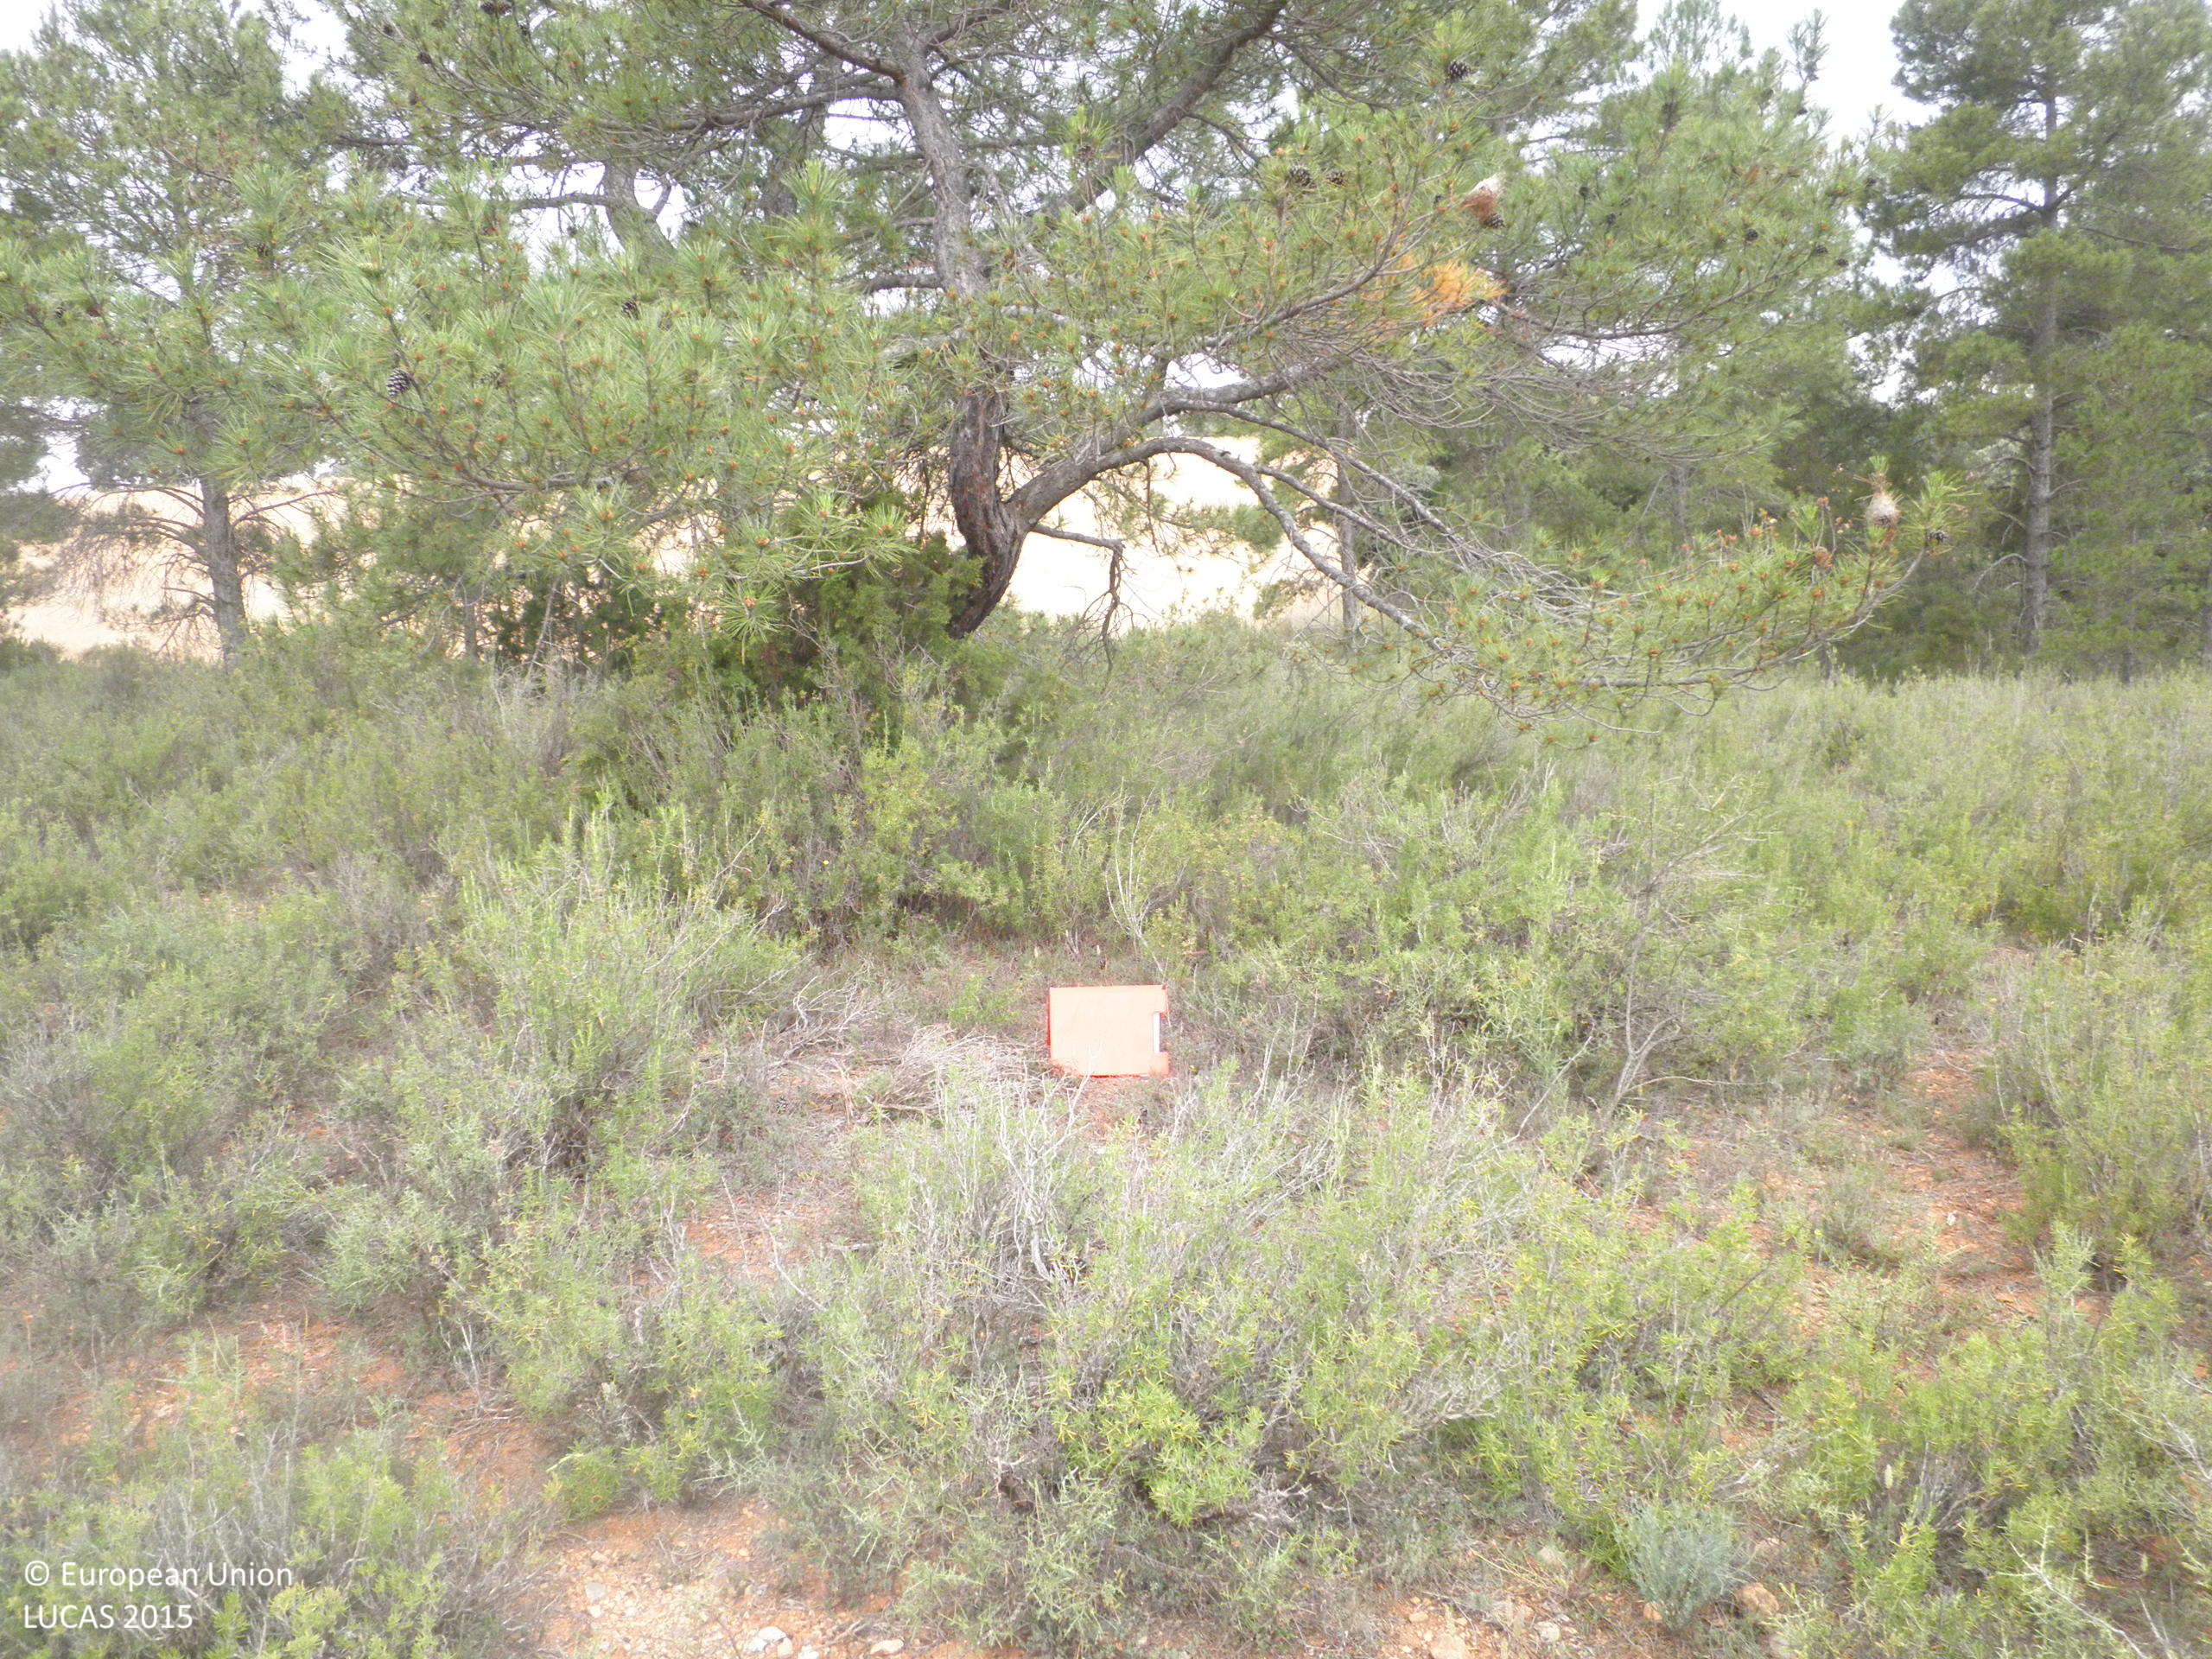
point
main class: Woodland
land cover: Pine dominated coniferous woodland
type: coniferous forest of the mediterranean region
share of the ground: 25 - 50 %
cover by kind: shrubs 60 %, coniferous forest trees 25 %, unconsolidated bare surface 15 %
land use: Semi-natural and natural areas not in use
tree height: > 5 m
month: June
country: ES
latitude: 39.5587
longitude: -1.7500
